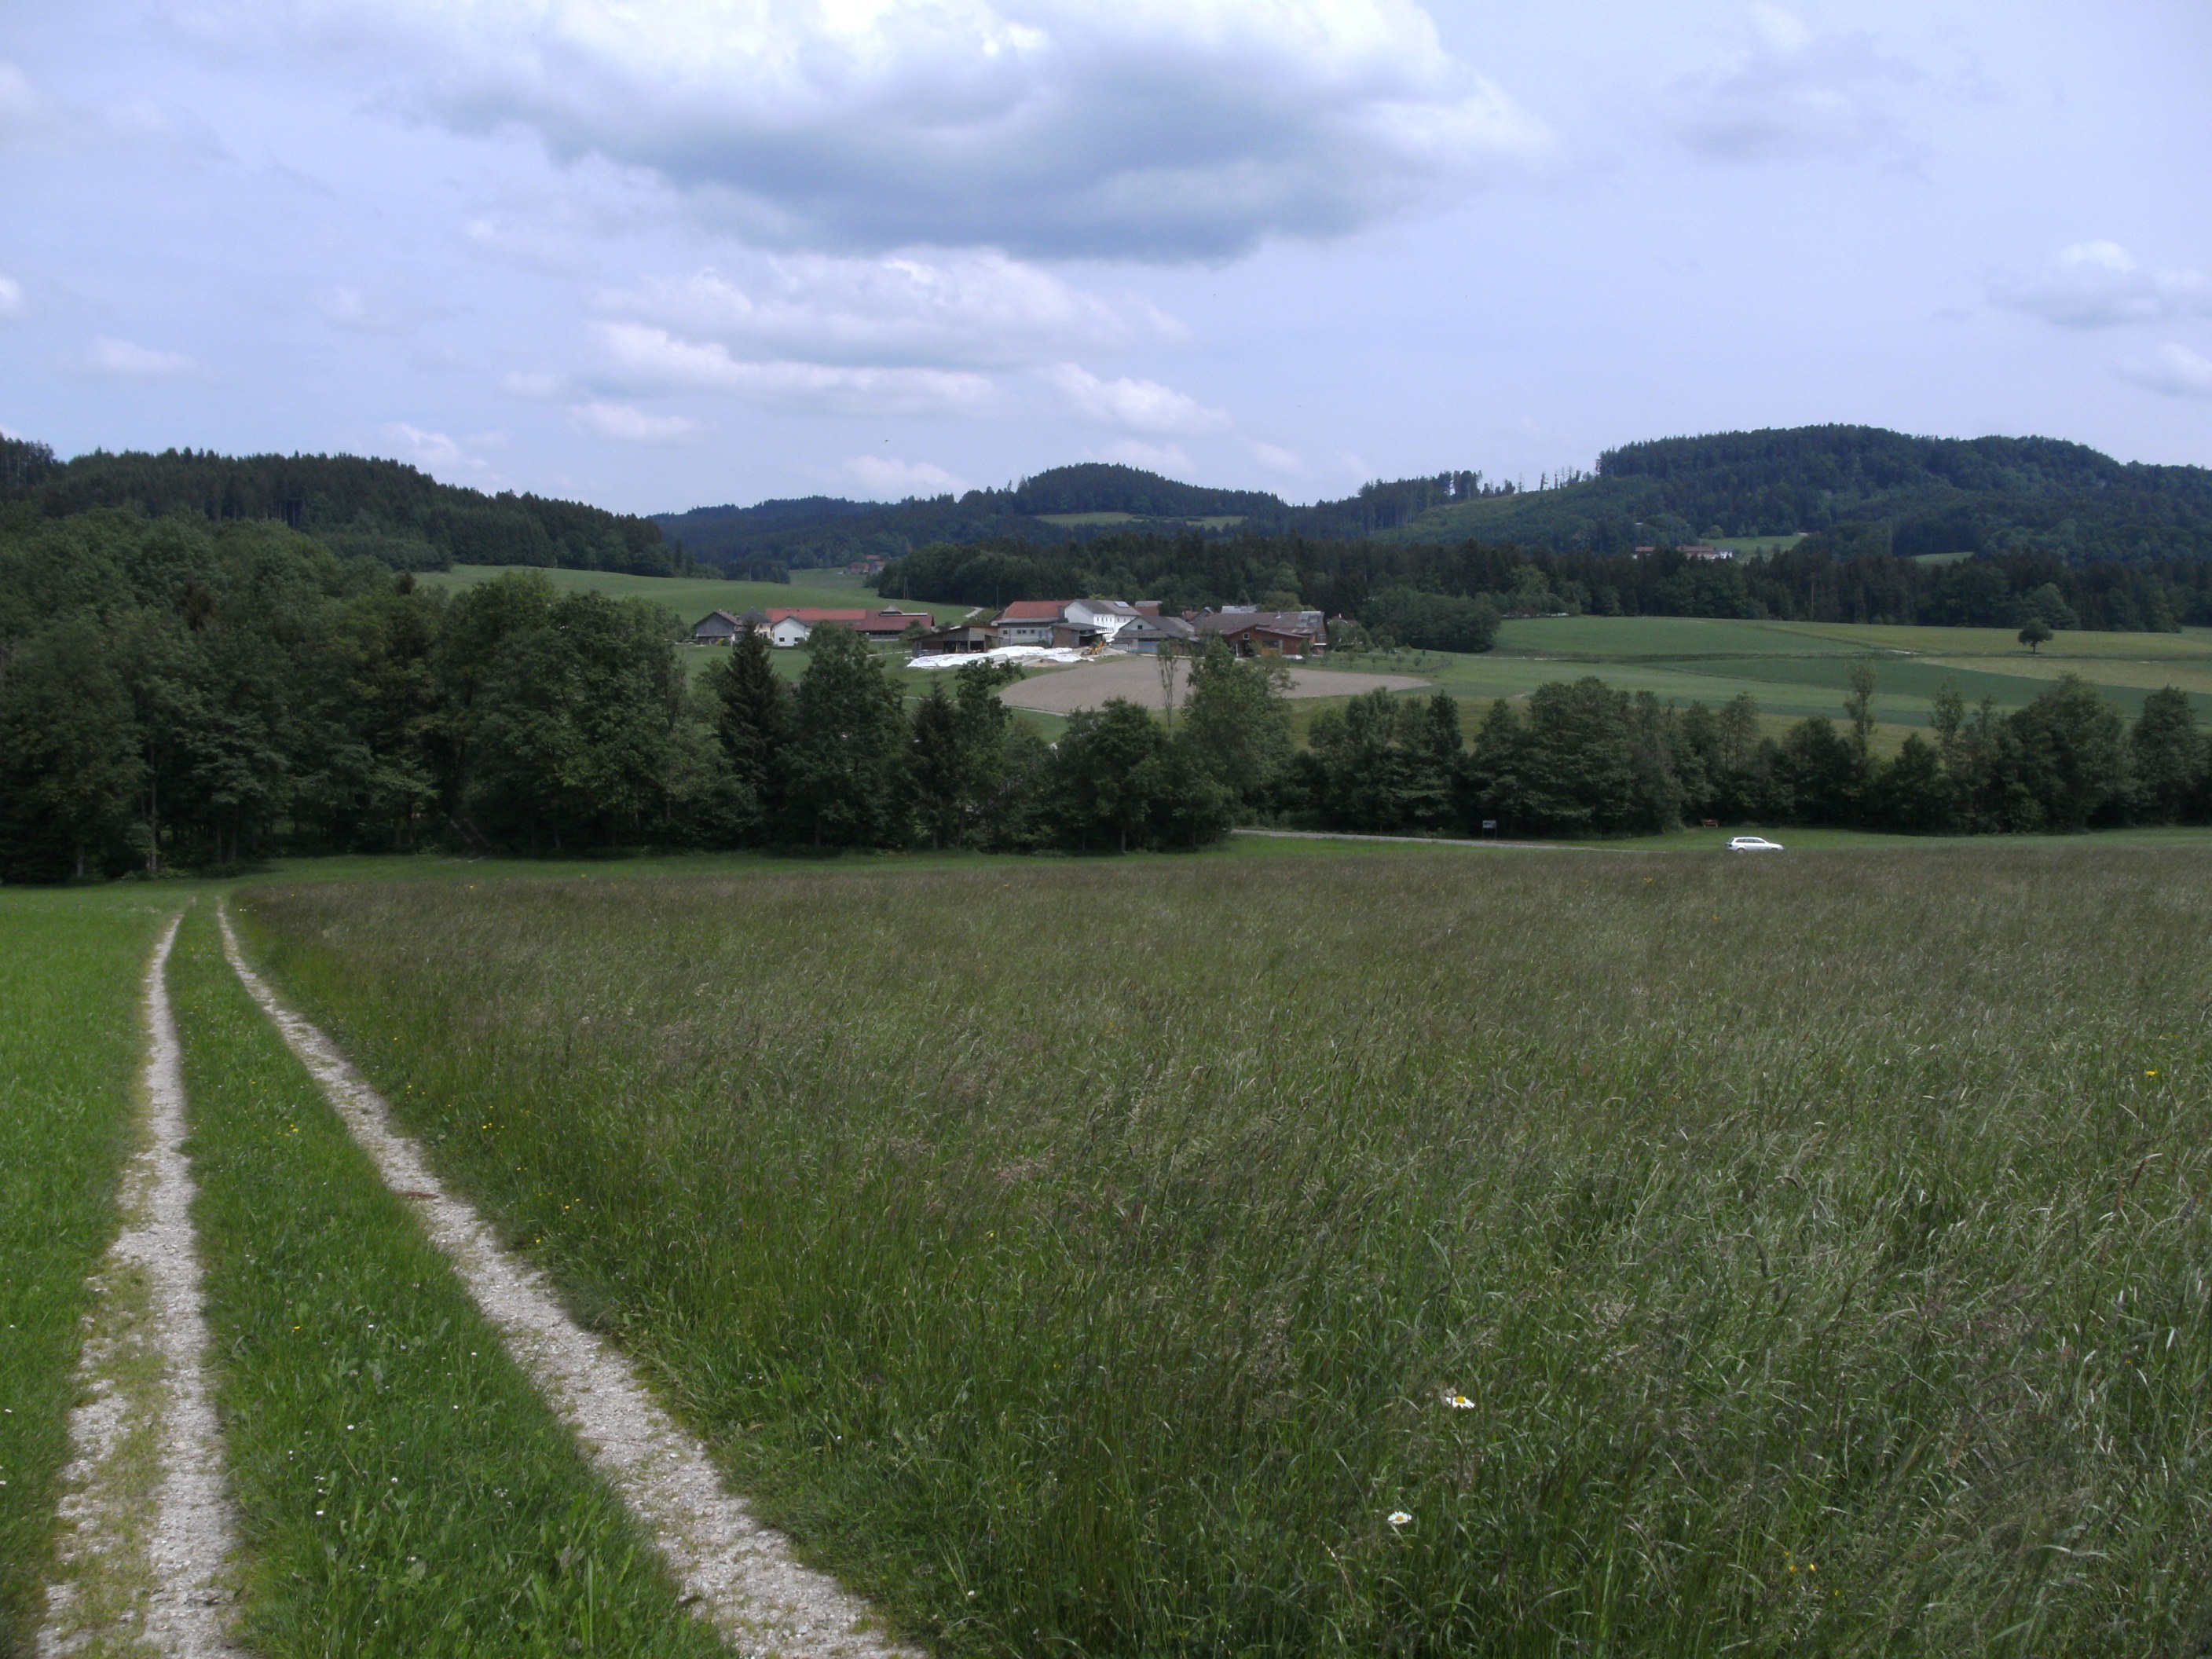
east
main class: Grassland
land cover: Grassland without tree/shrub cover
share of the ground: > 75 %
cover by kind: herbaceous plants 100 %
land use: Agriculture (excluding fallow land and kitchen gardens)
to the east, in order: Grassland without tree/shrub cover; Tracks; Grassland without tree/shrub cover; Broadleaved woodland; Rivers and streams; Broadleaved woodland; Grassland without tree/shrub cover
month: June
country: AT
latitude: 48.0967
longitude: 13.4769
